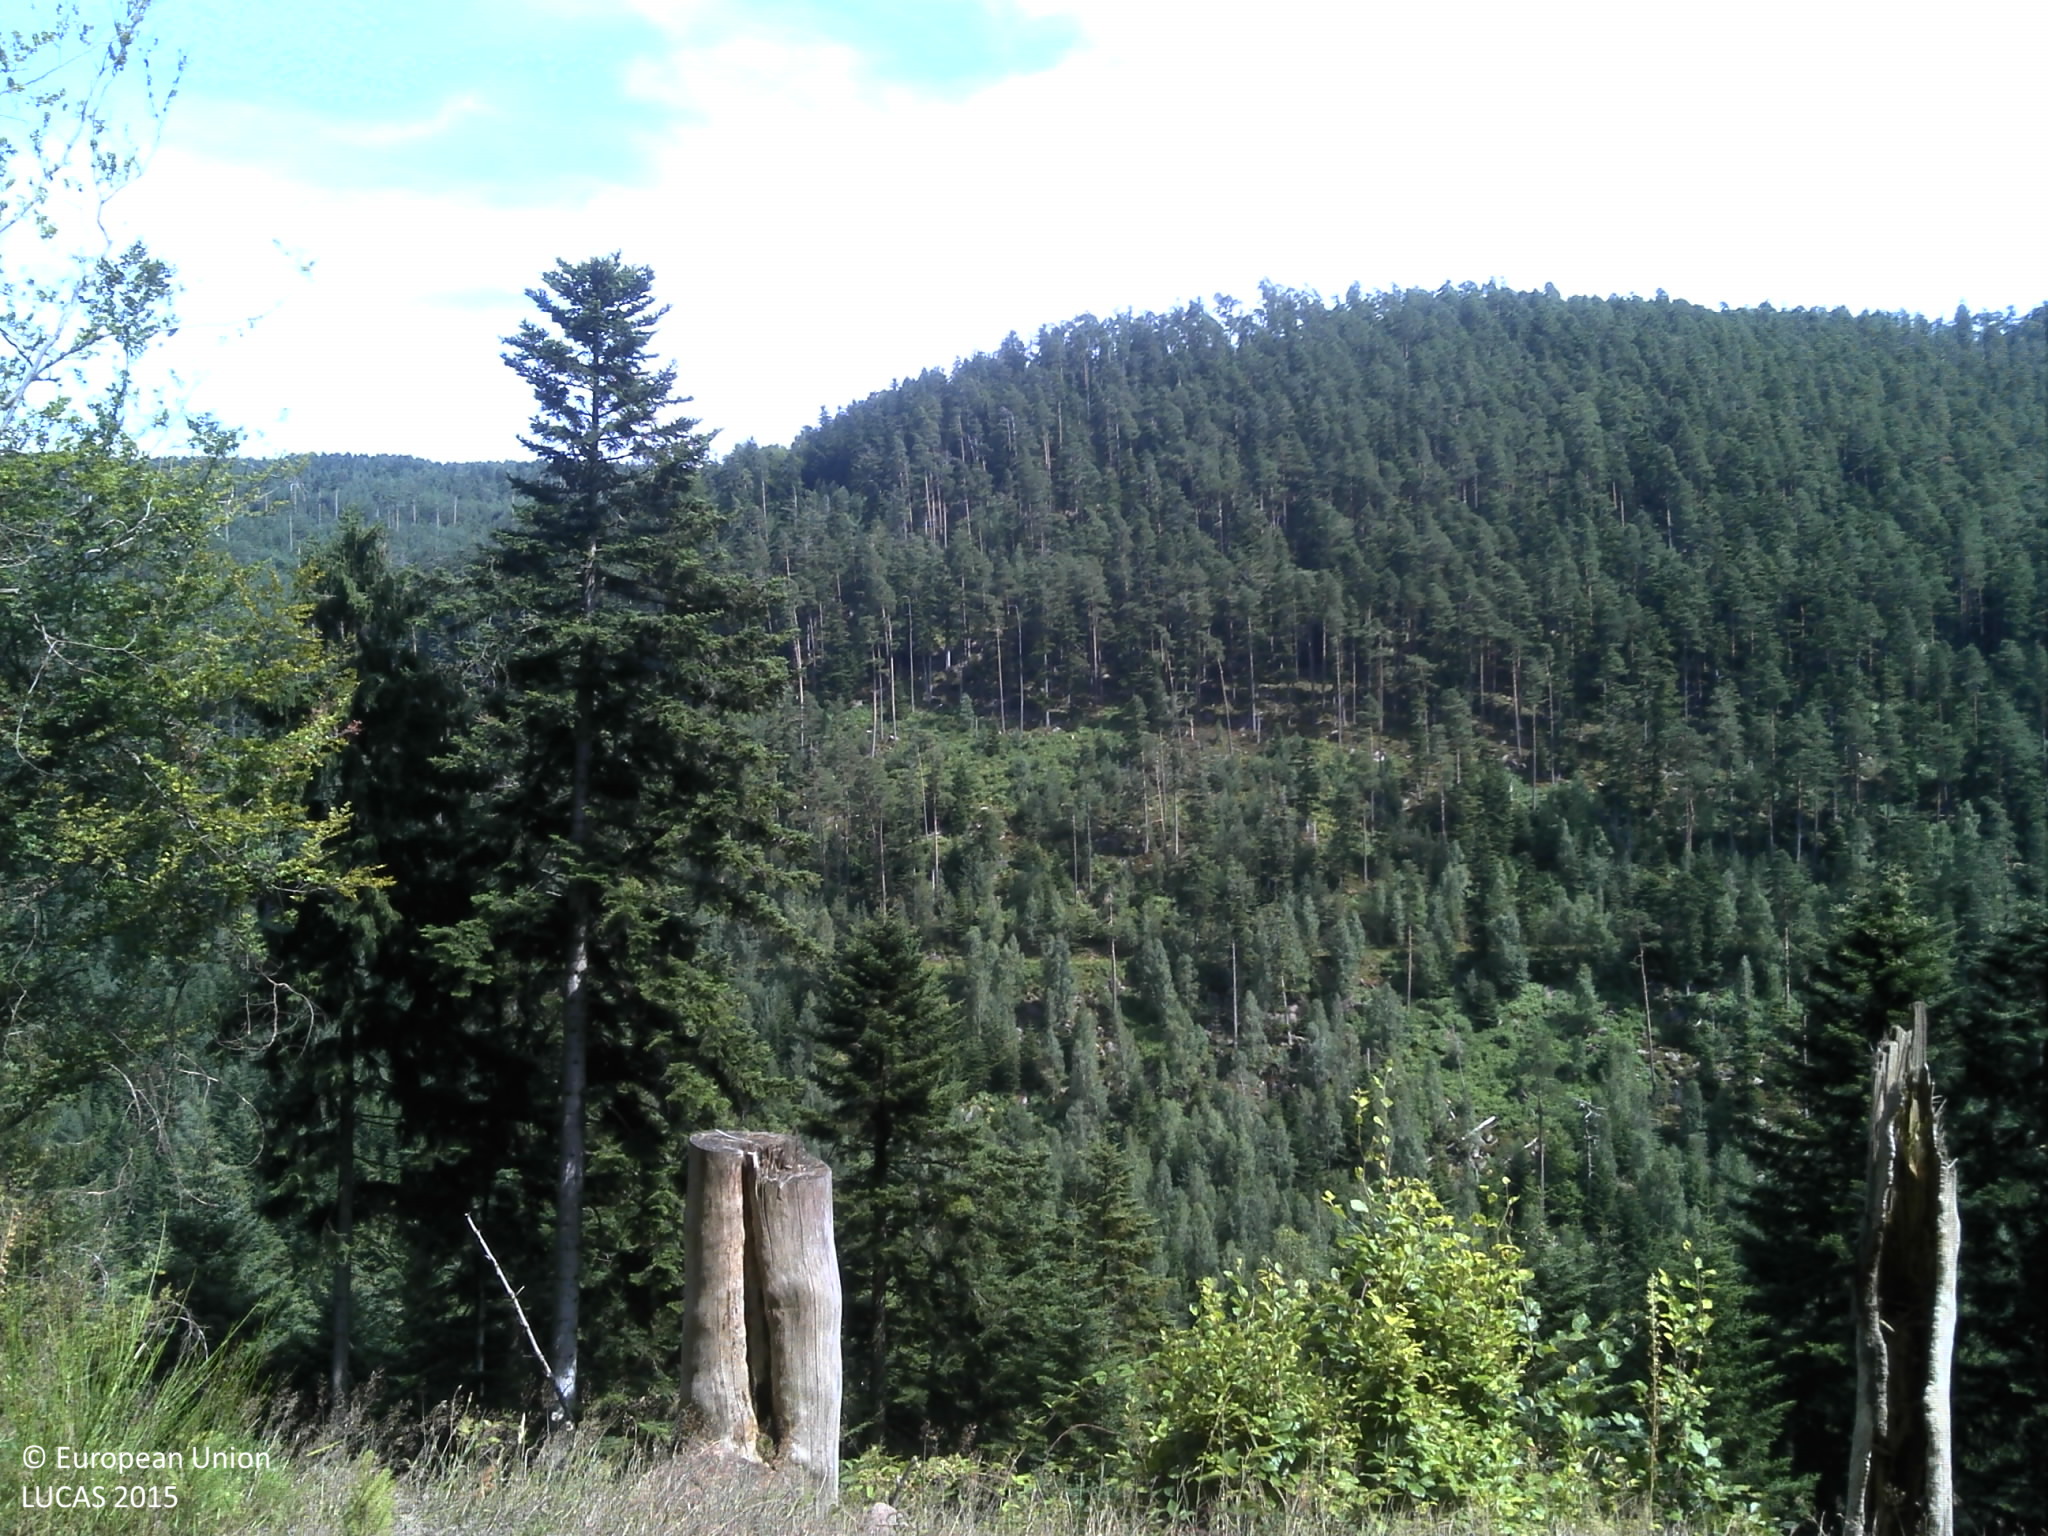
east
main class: Woodland
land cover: Spruce dominated mixed woodland
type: hemiboreal forest and nemoral coniferous forest and mixed broadleaved-coniferous forest
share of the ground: > 75 %
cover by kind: coniferous forest trees 40 %, broadleaved forest trees 40 %, shrubs 10 %, herbaceous plants 10 %
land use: Forestry
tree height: > 5 m
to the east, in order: Tracks; Grass margins; Shrubland with sparse tree cover; Spruce dominated mixed woodland; Grass margins; Tracks; Grass margins; Spruce dominated mixed woodland; Grass margins; Dry stone walls; Paved roads, cycling and walking lanes; Grass margins; Rivers and streams; Lines of trees; Grass margins; Electric lines; Rock outcrops; Spruce dominated mixed woodland; Spruce dominated coniferous woodland
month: July
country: FR
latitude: 48.6219
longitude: 7.2739
